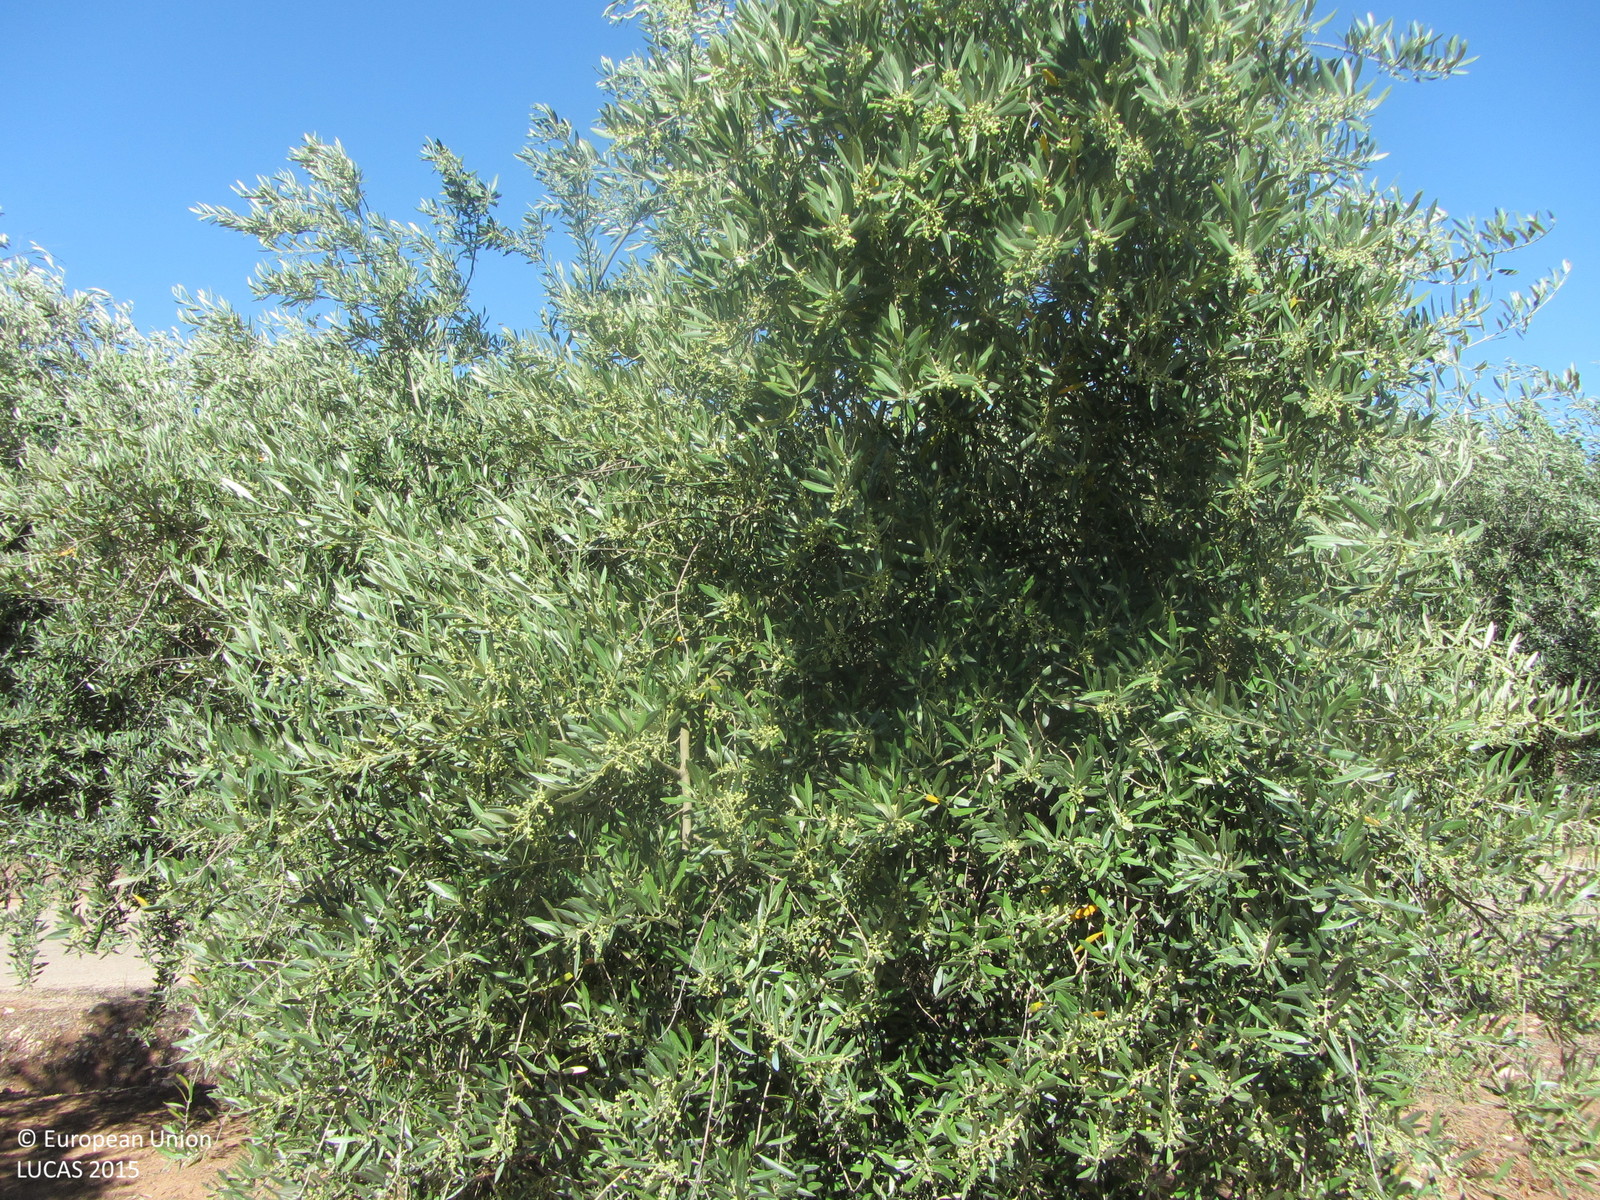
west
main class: Cropland
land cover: Olive groves
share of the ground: 25 - 50 %
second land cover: Spontaneously vegetated surfaces
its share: 10 - 25 %
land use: Agriculture (excluding fallow land and kitchen gardens)
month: May
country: ES
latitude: 38.2272
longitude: -3.1262
